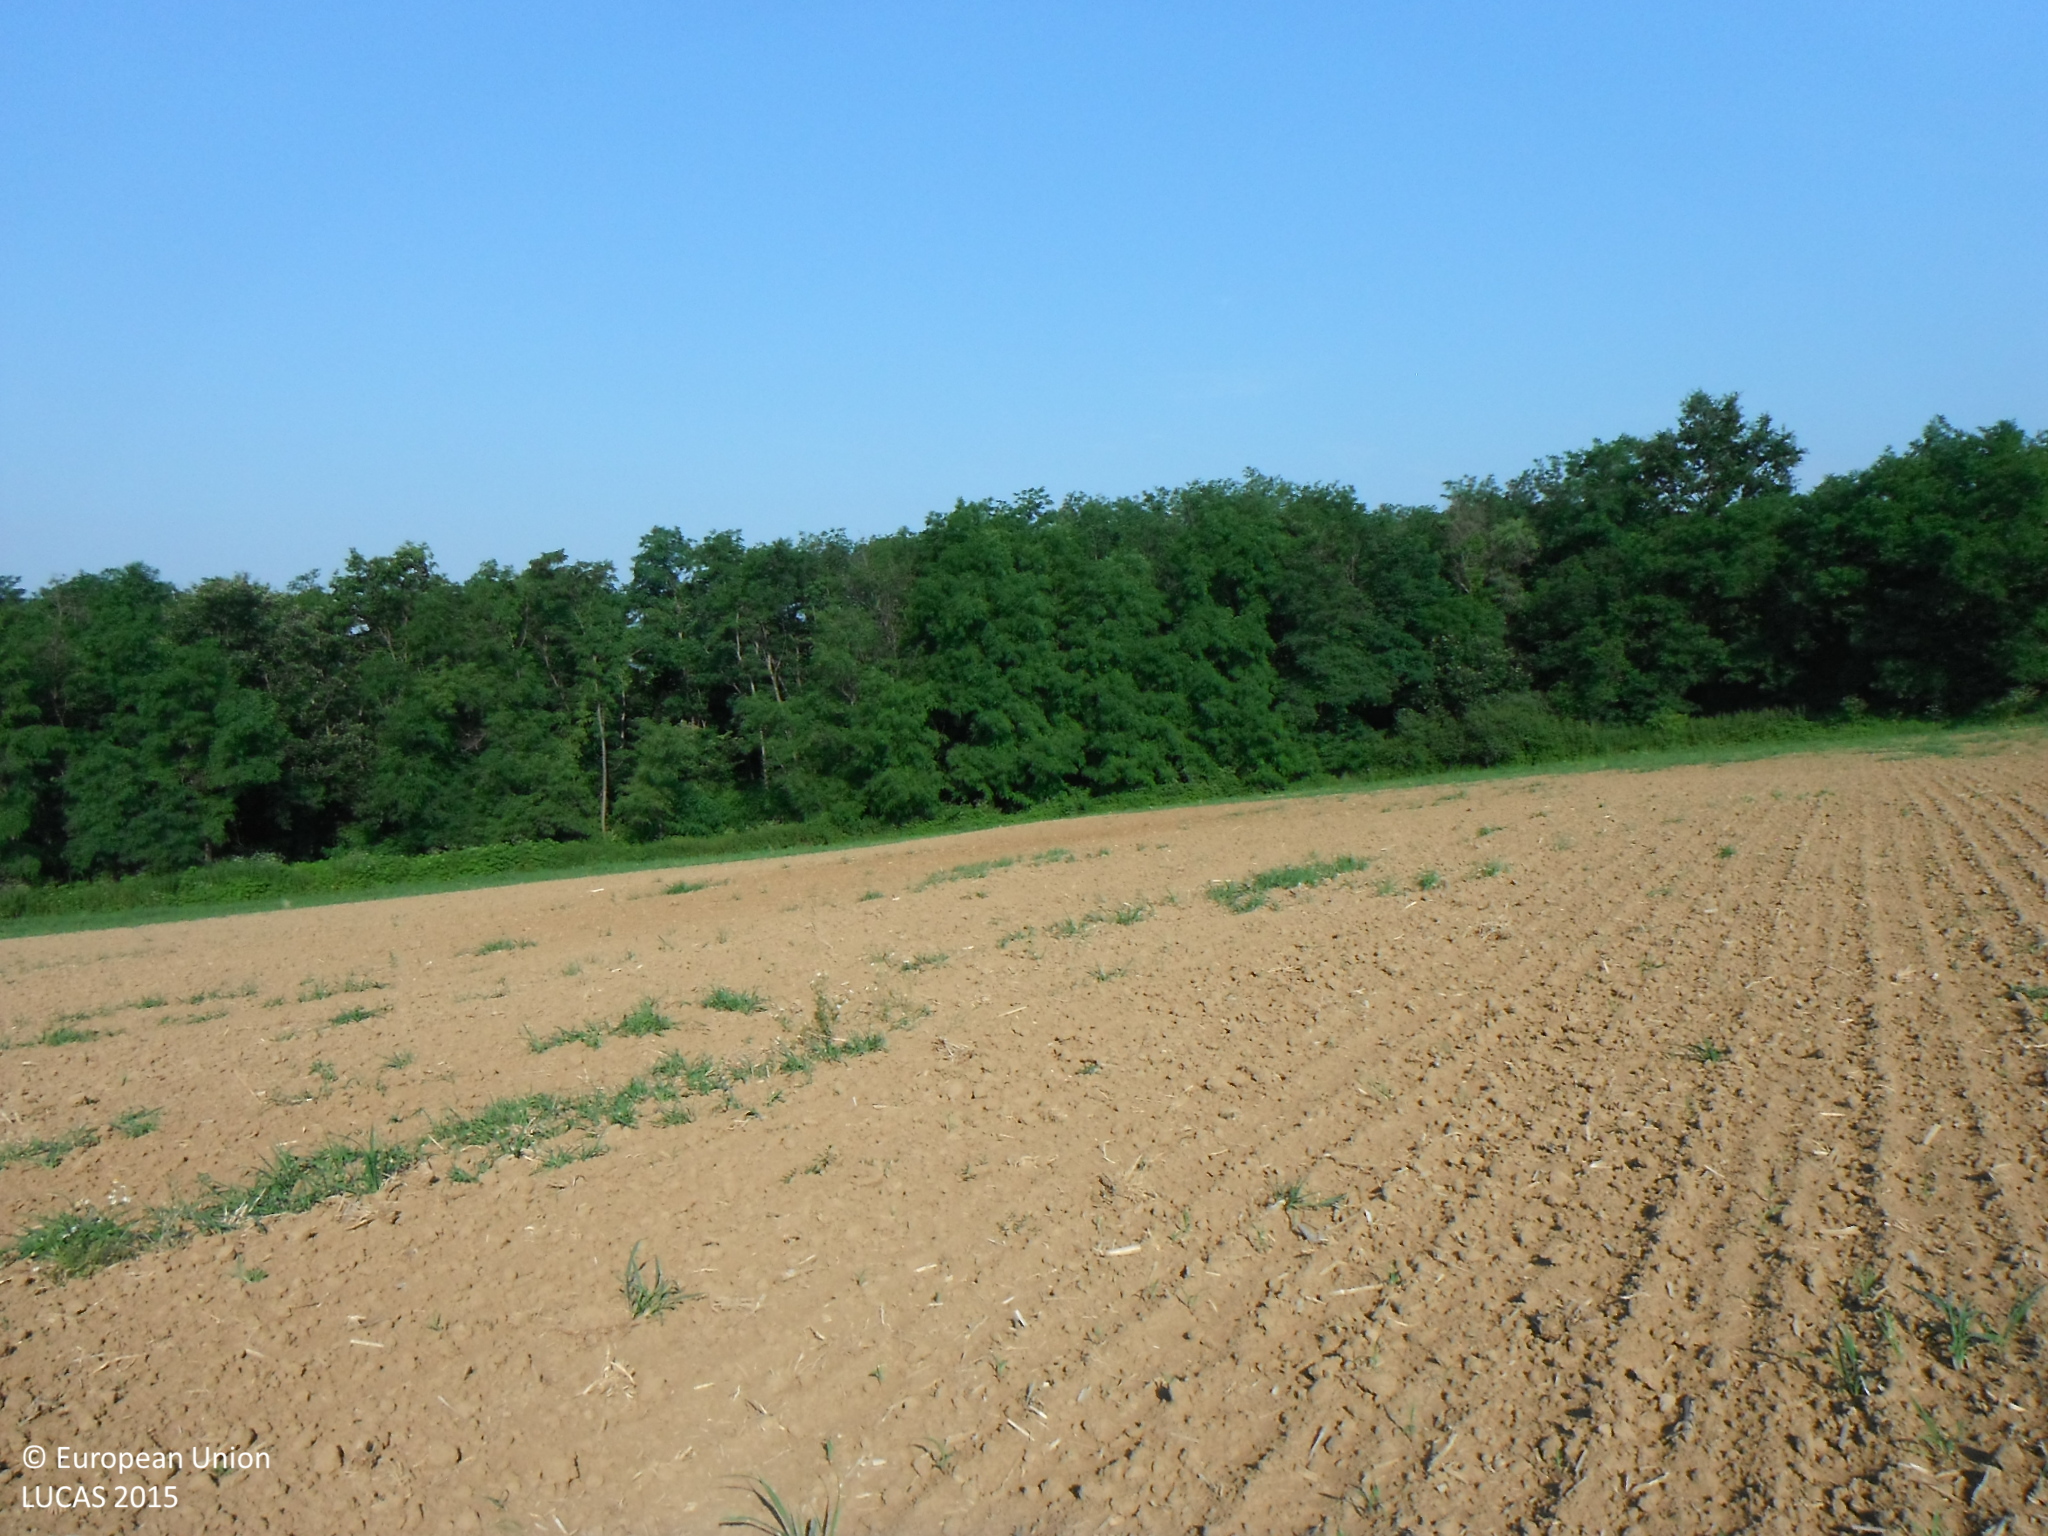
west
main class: Cropland
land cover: Maize
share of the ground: < 10 %
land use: Agriculture (excluding fallow land and kitchen gardens)
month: July
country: SK
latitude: 48.2325
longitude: 19.4613
